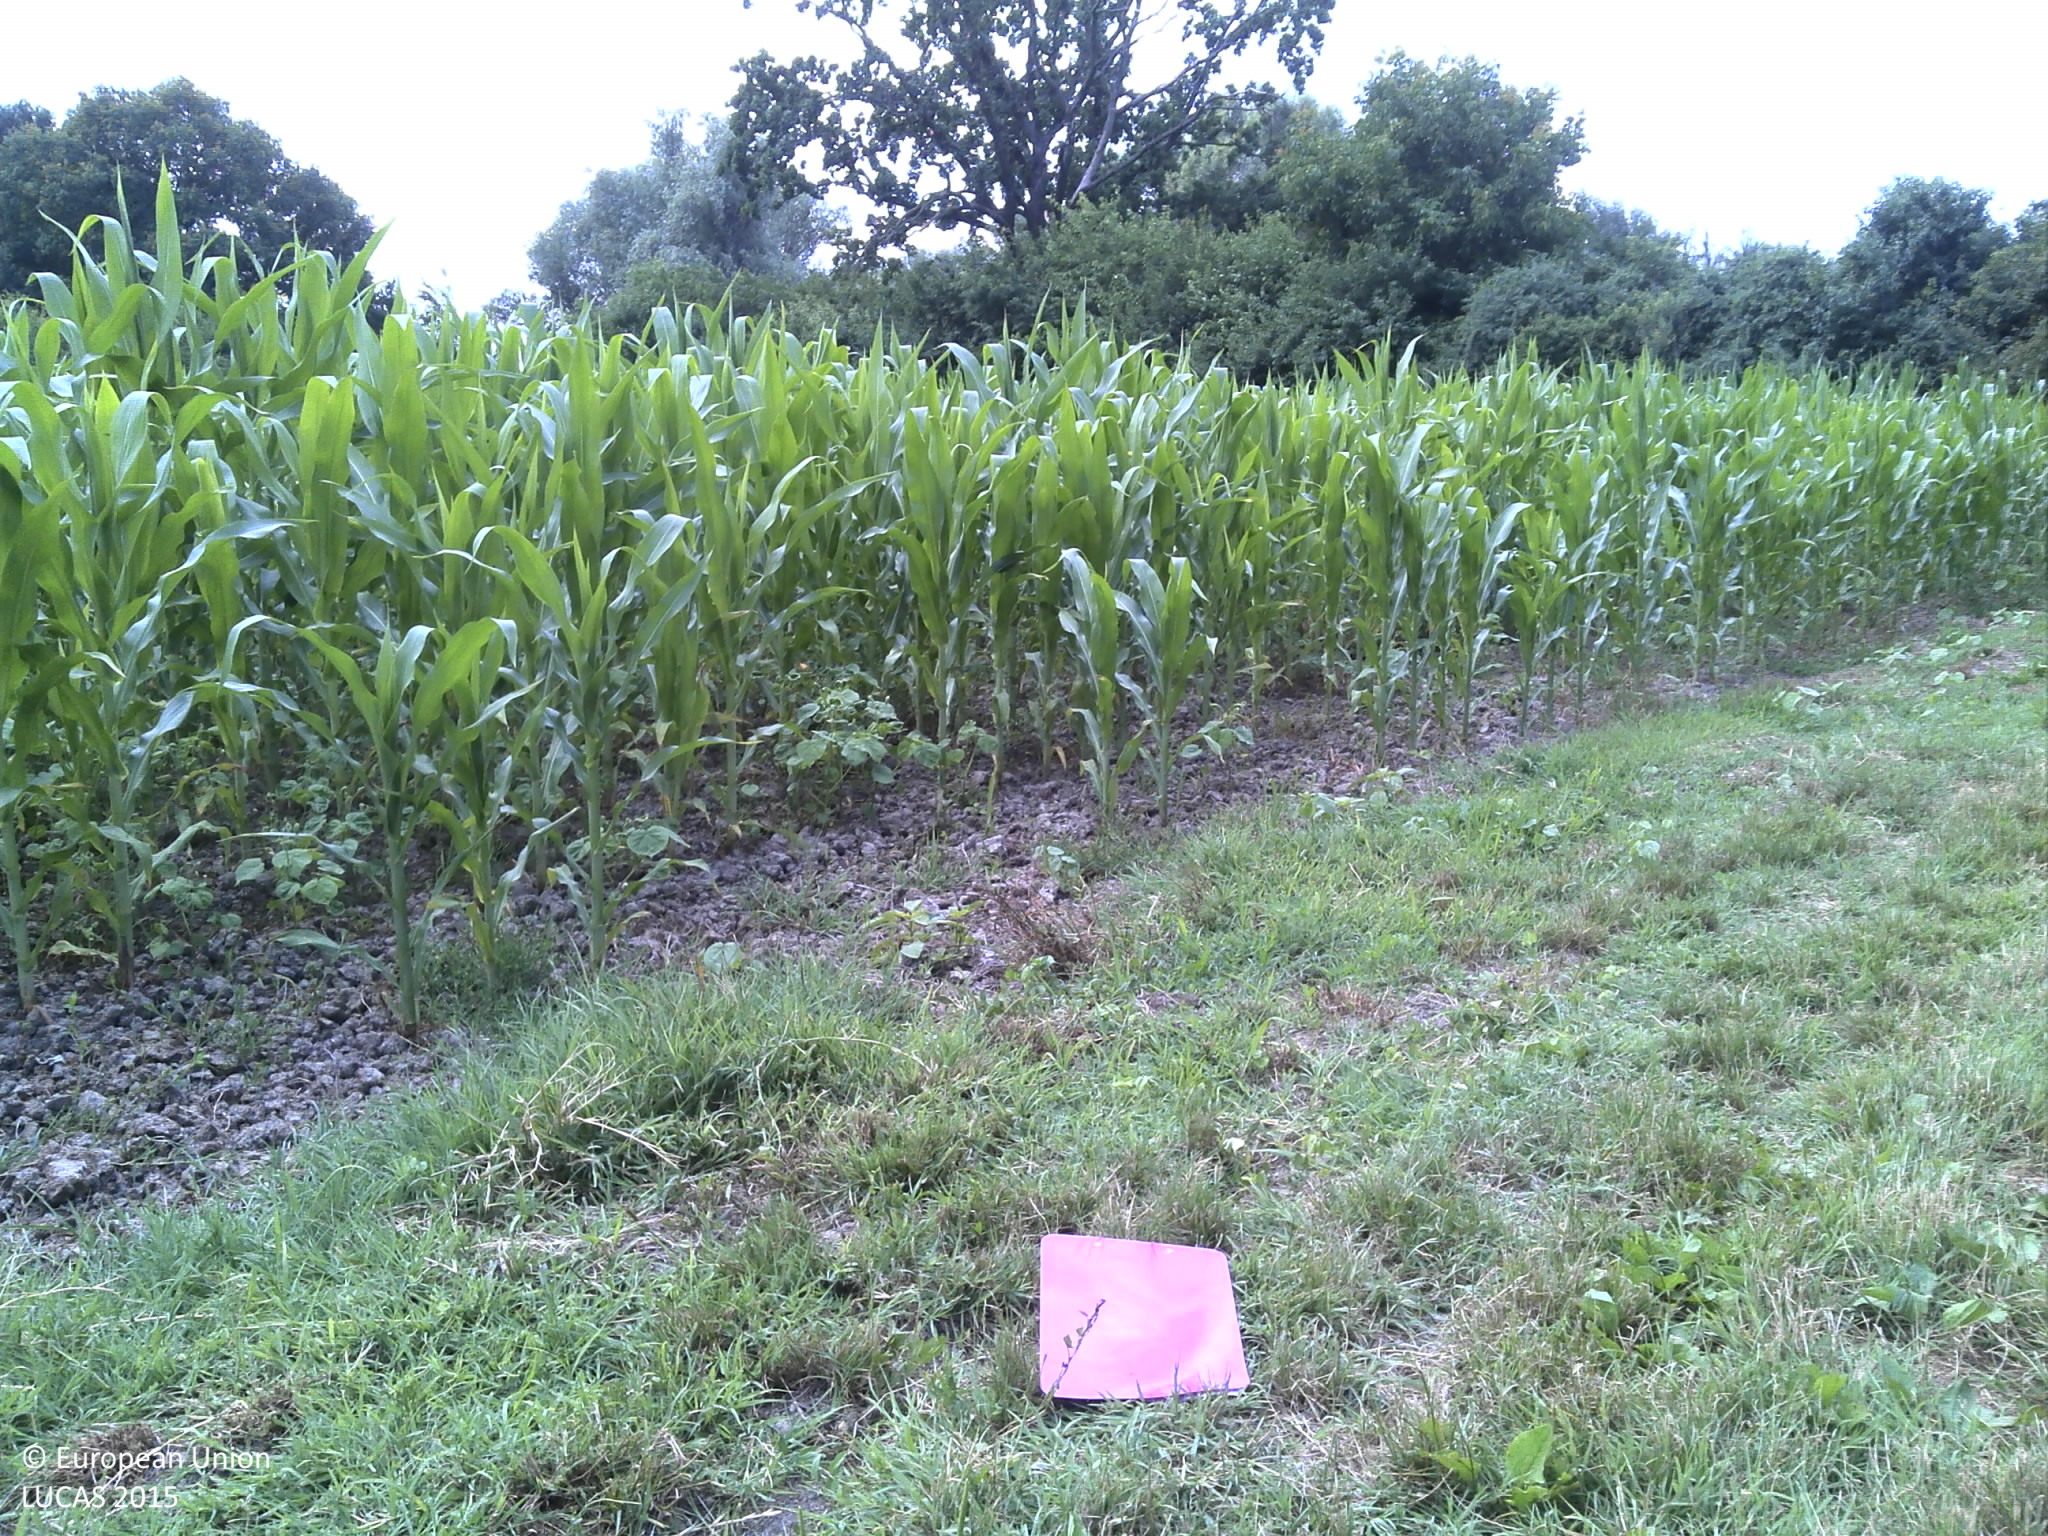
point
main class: Grassland
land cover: Grassland without tree/shrub cover
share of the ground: > 75 %
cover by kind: herbaceous plants 100 %
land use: Agriculture (excluding fallow land and kitchen gardens)
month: June
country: HR
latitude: 45.5080
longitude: 18.4667
